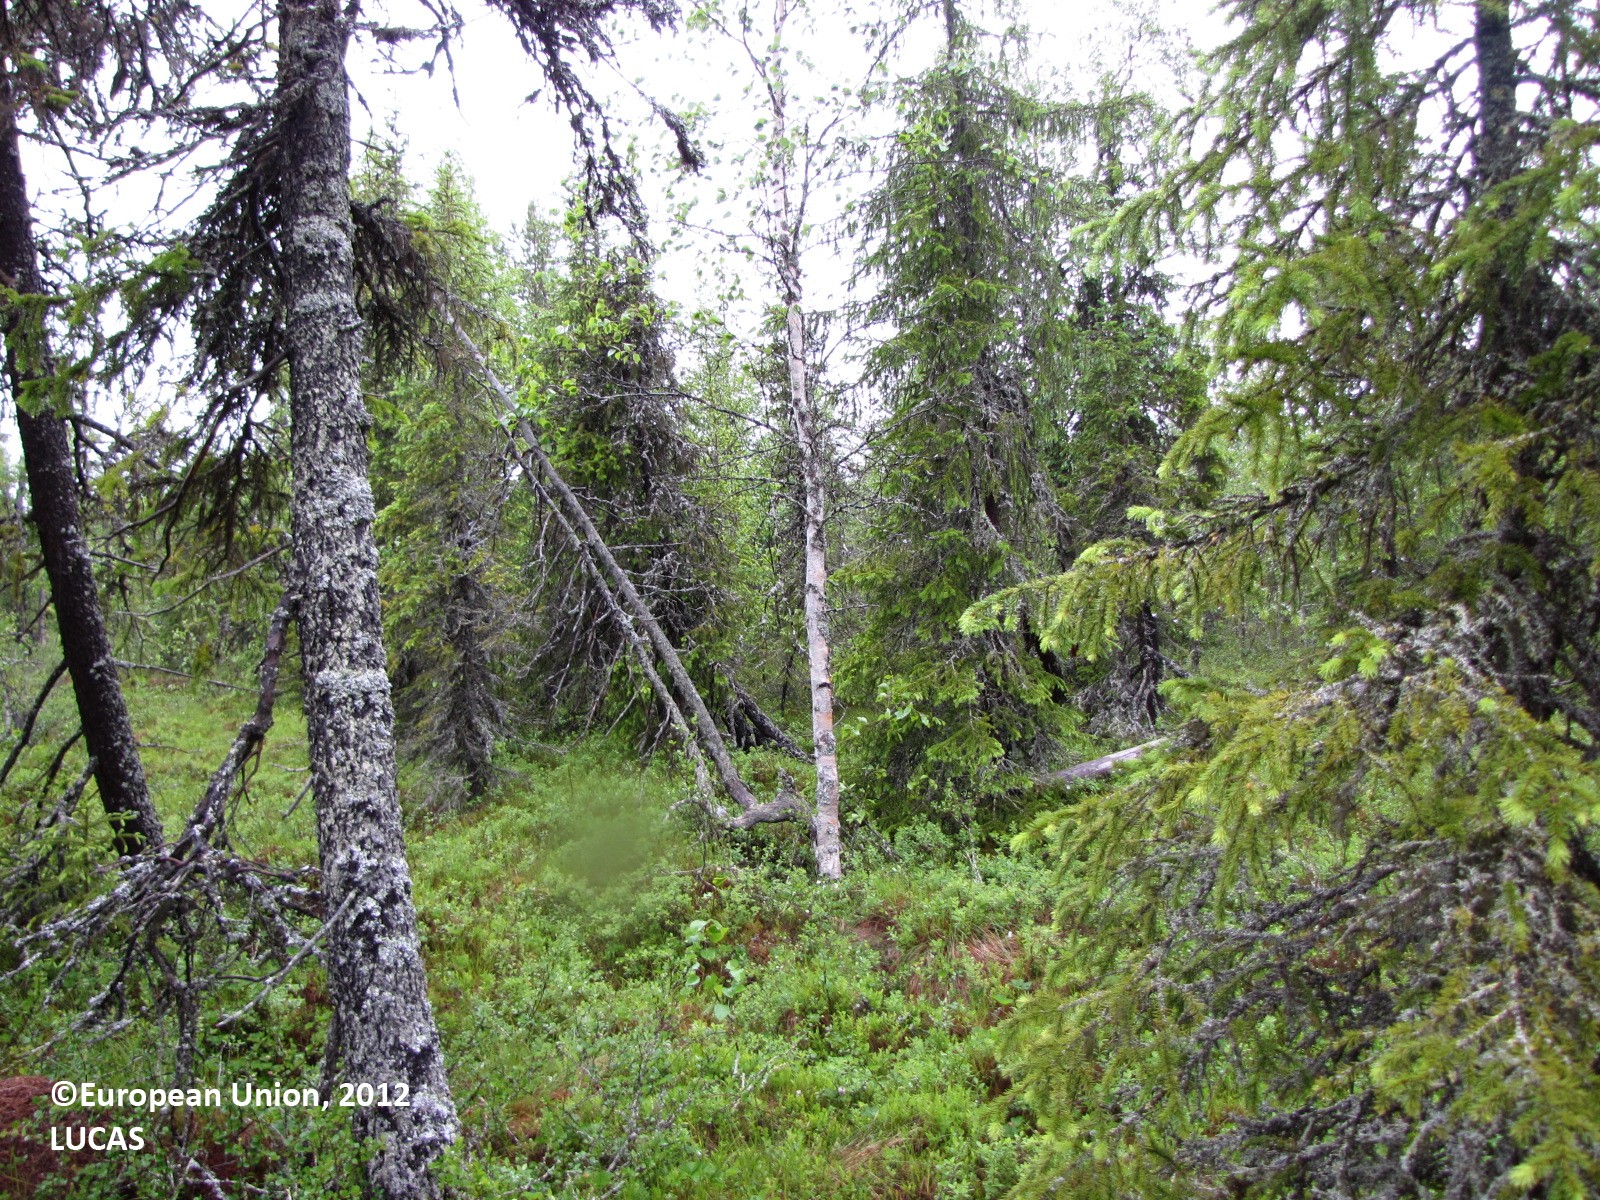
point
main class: Woodland
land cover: Spruce dominated coniferous woodland
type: boreal forest
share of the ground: 50 - 75 %
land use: Forestry
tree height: > 5 m
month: June
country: FI
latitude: 66.3692
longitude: 24.4659
